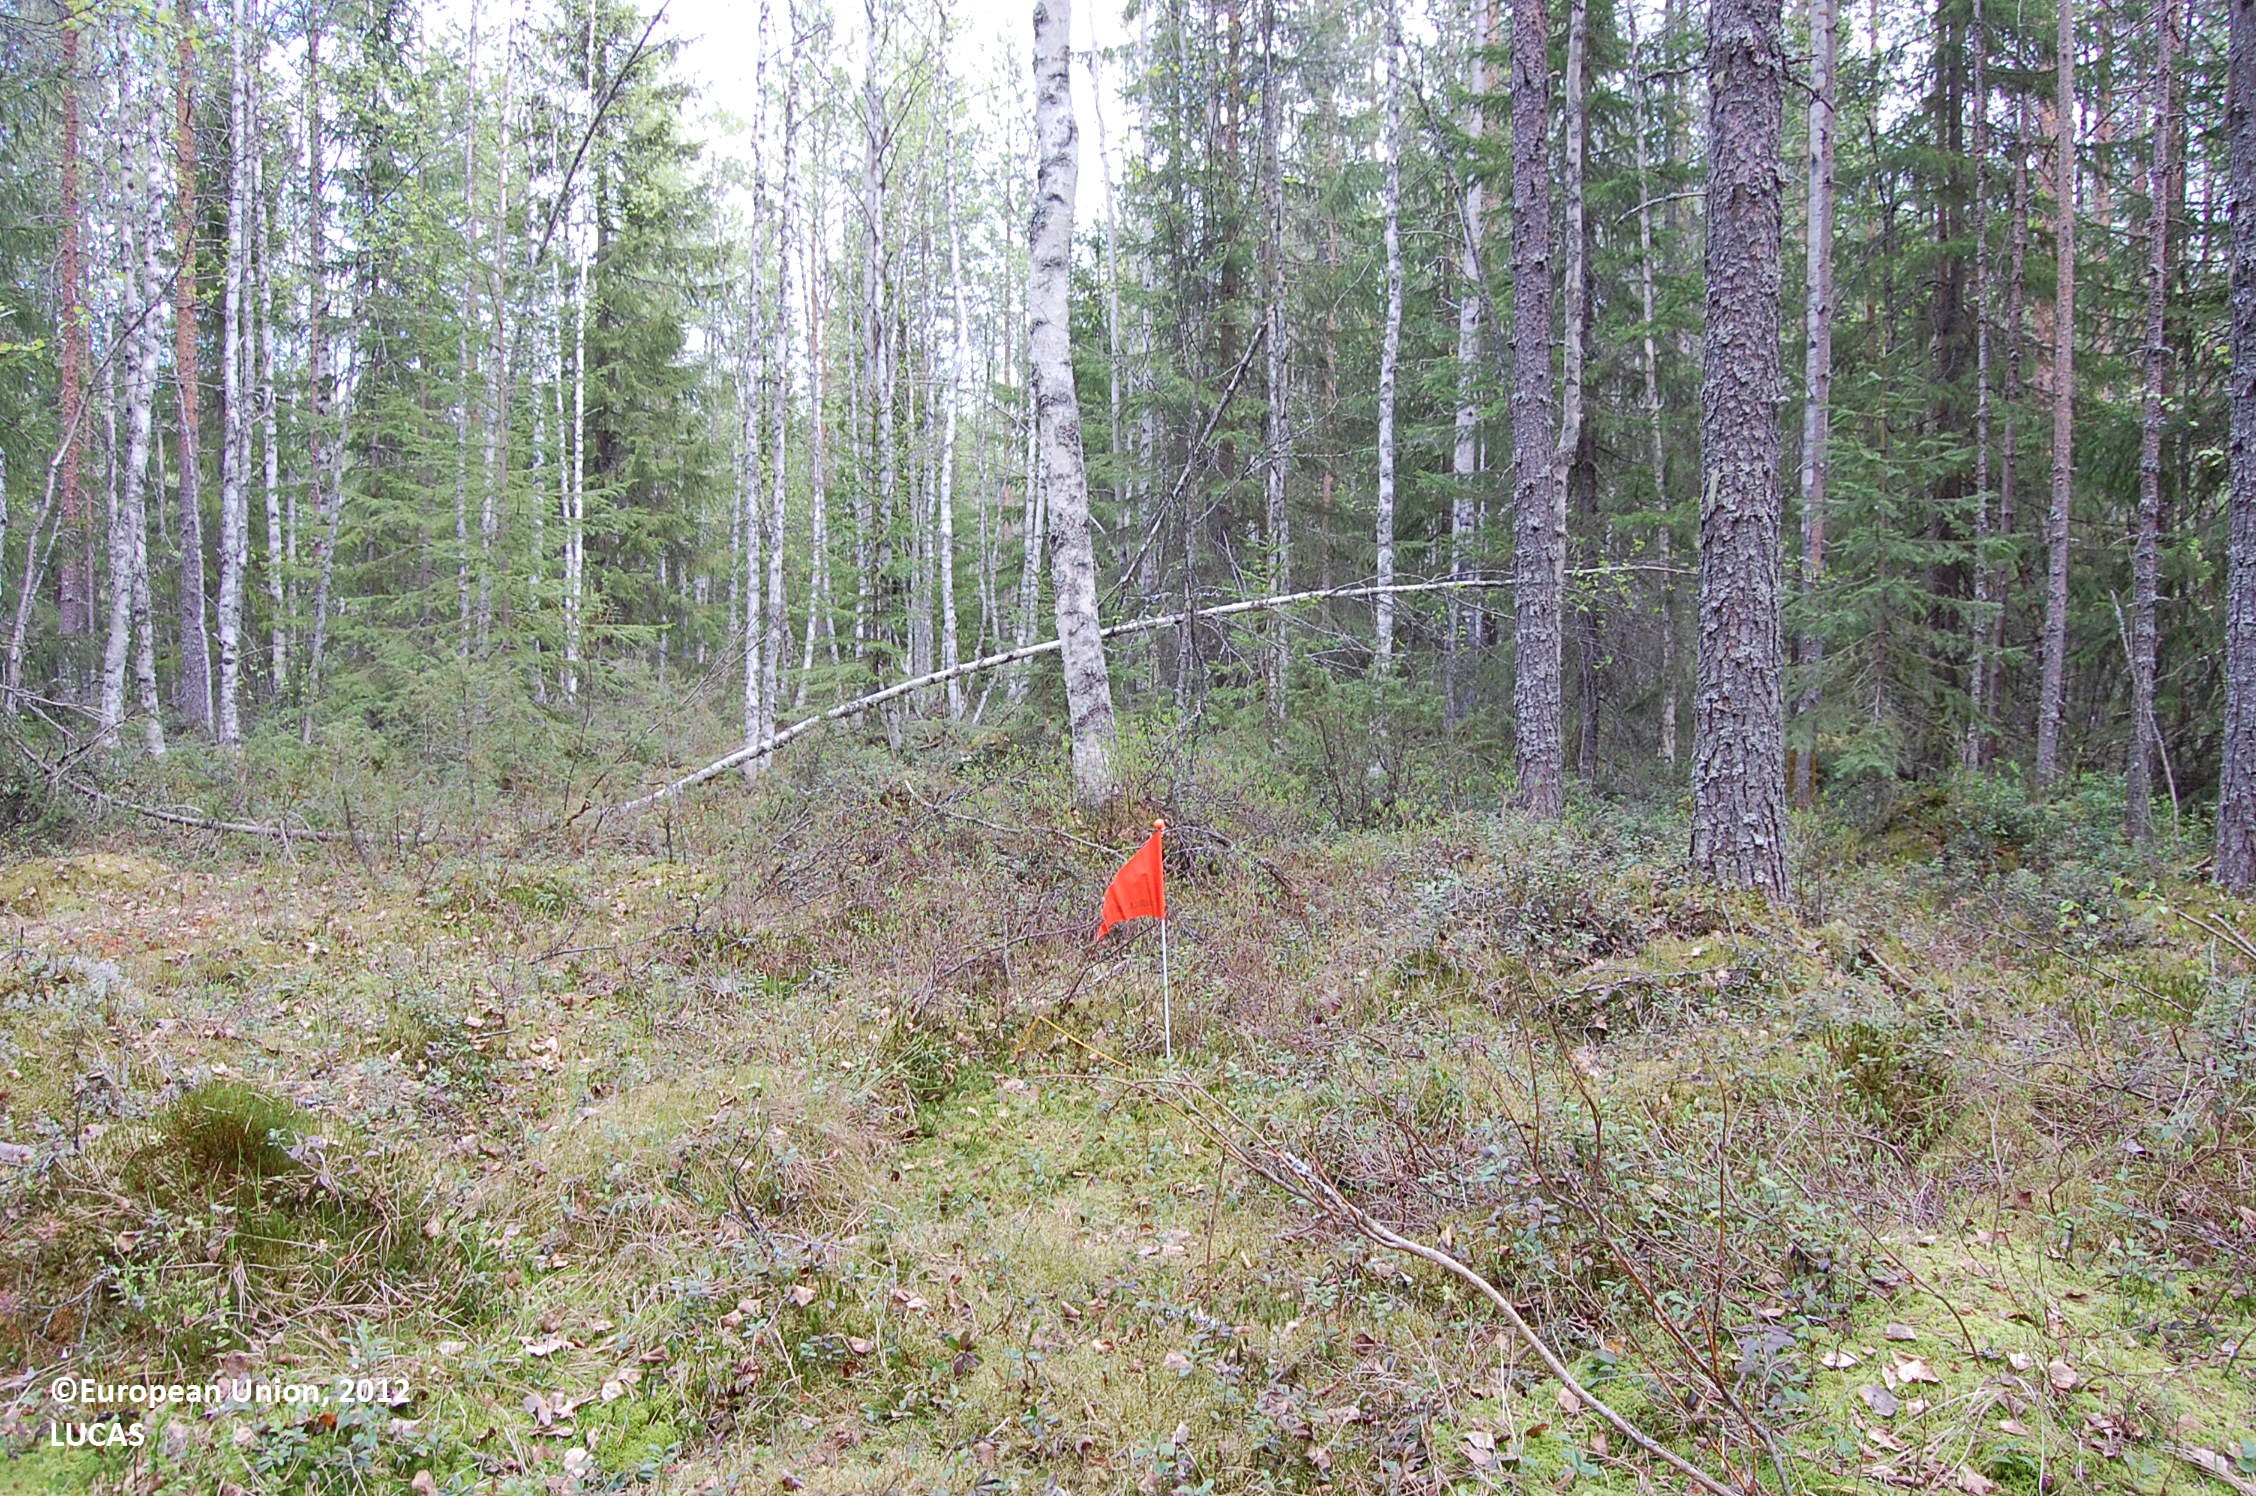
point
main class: Woodland
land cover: Other mixed woodland
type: boreal forest
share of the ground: > 75 %
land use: Forestry
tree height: > 5 m
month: May
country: FI
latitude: 64.3632
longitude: 26.2892
